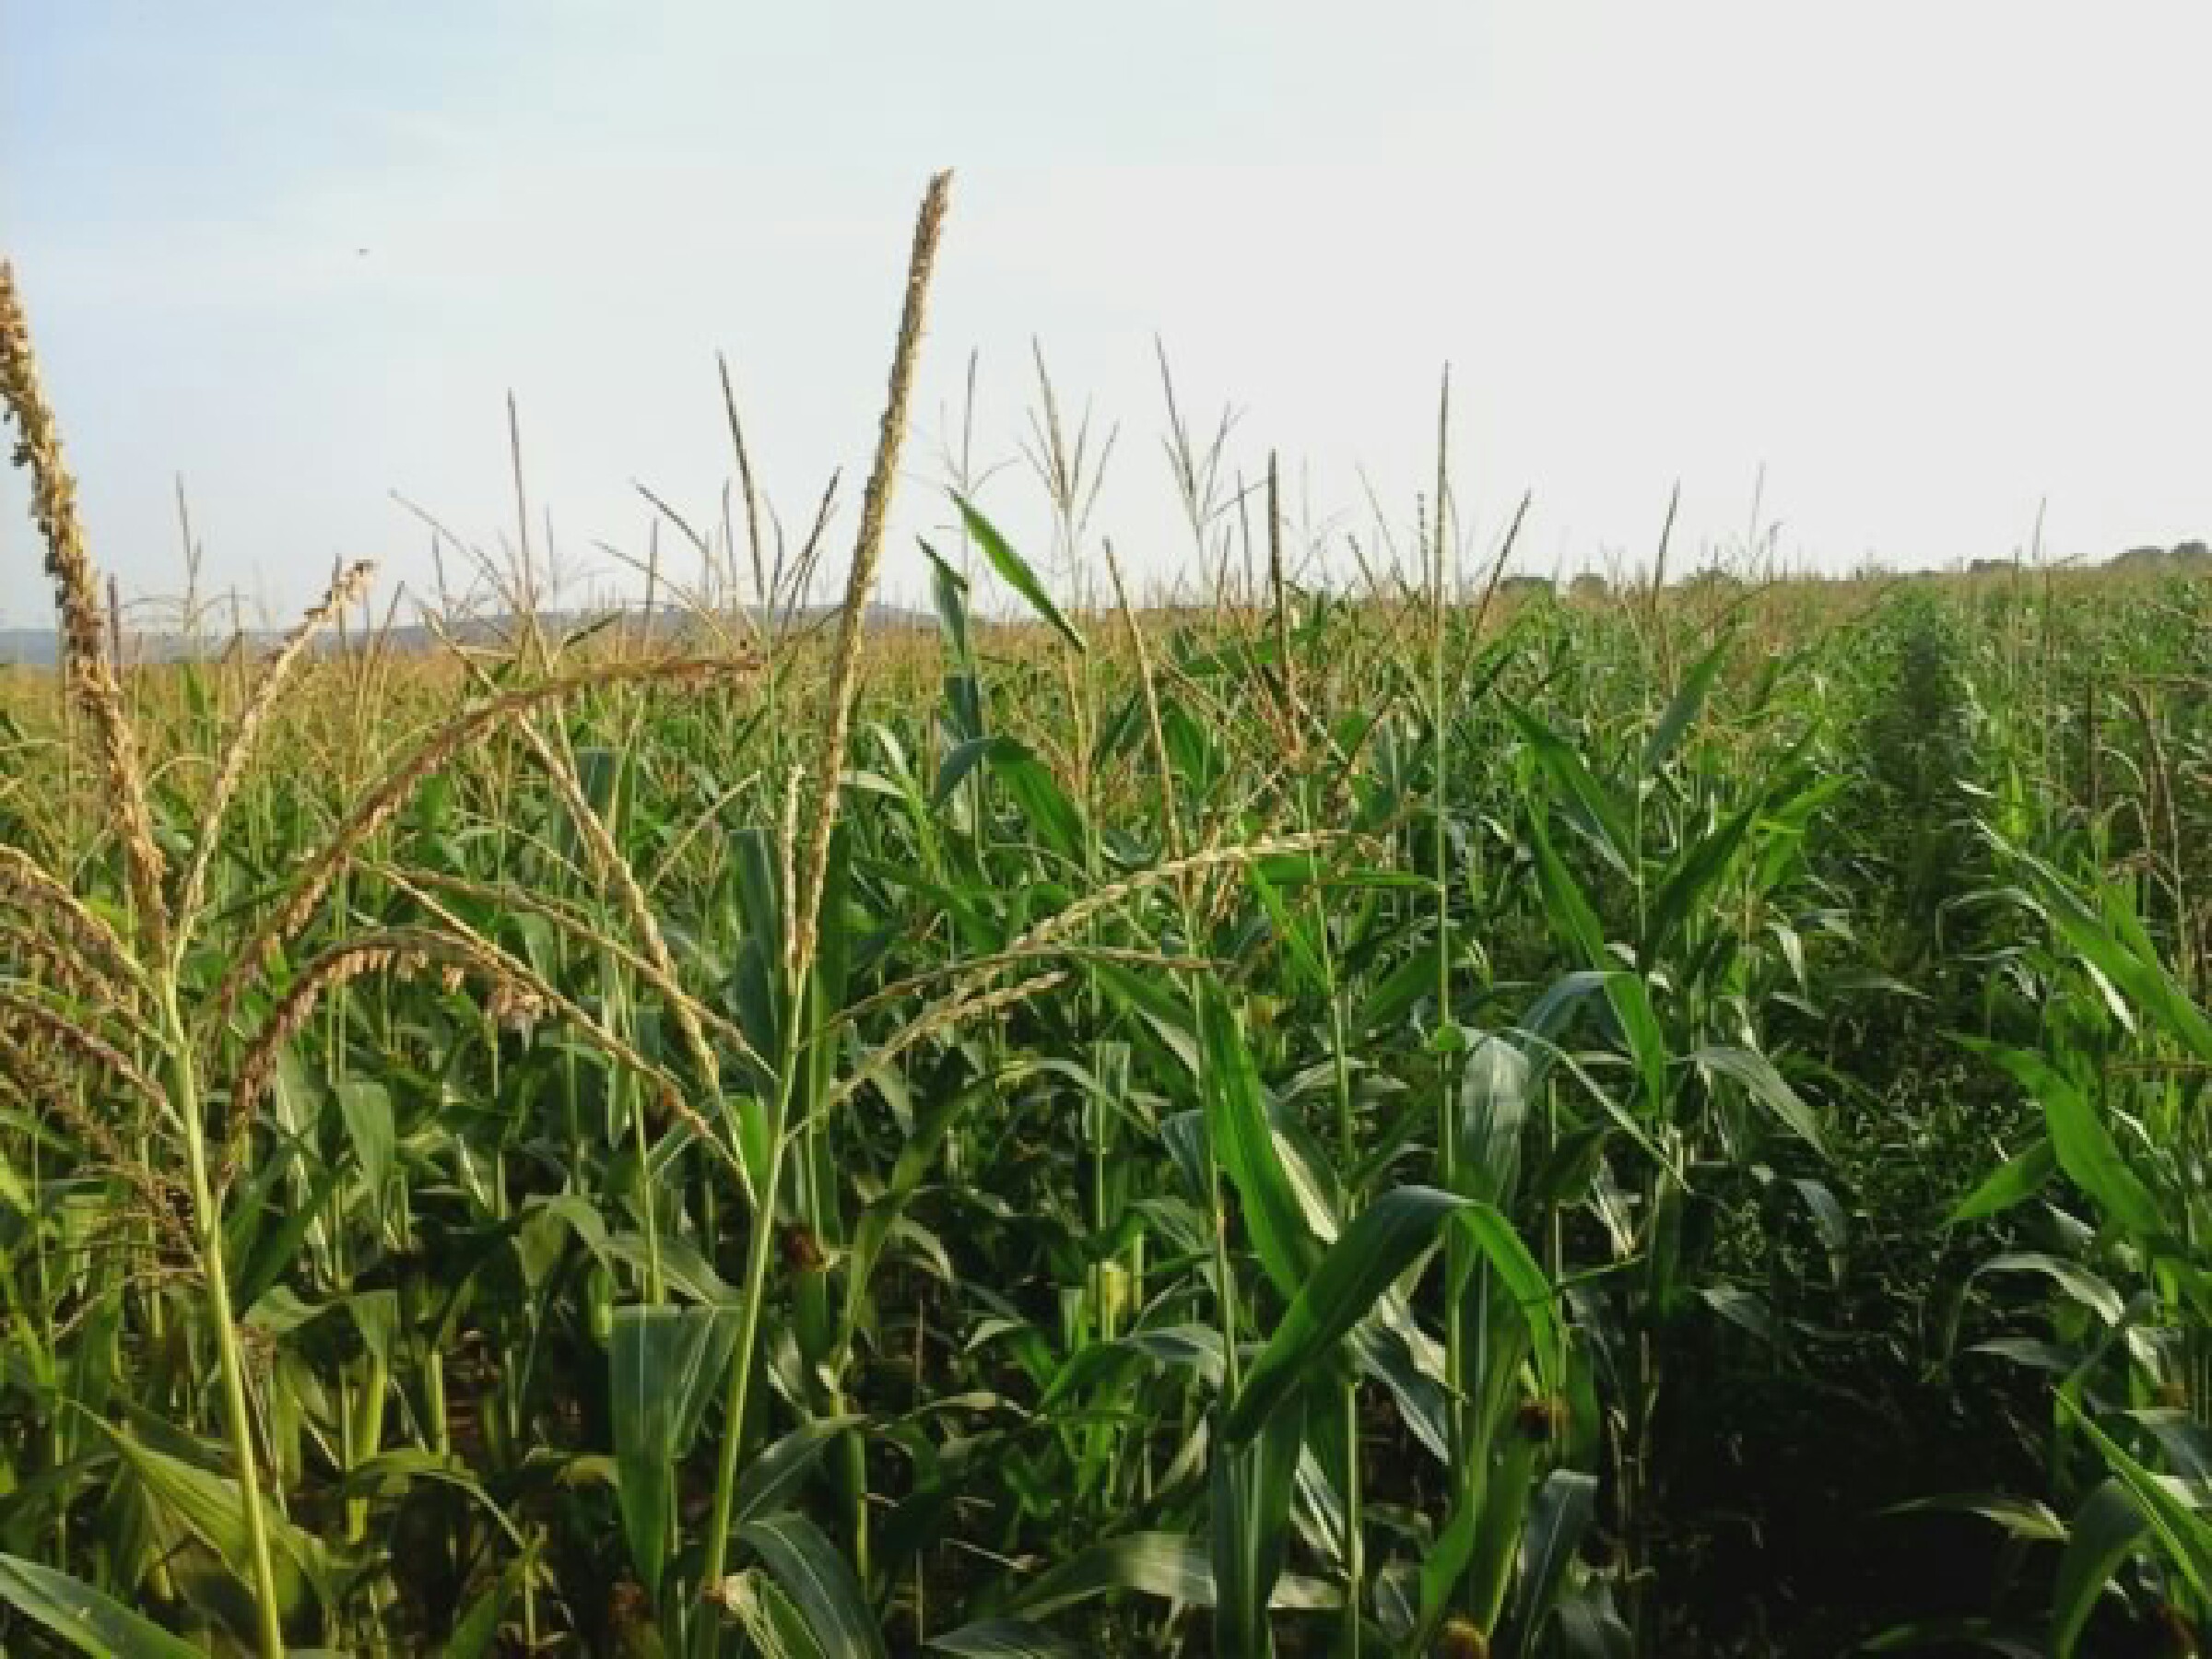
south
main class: Cropland
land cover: Maize
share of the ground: > 75 %
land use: Agriculture (excluding fallow land and kitchen gardens)
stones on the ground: < 10 %
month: August
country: HU
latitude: 48.0565
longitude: 19.4013
